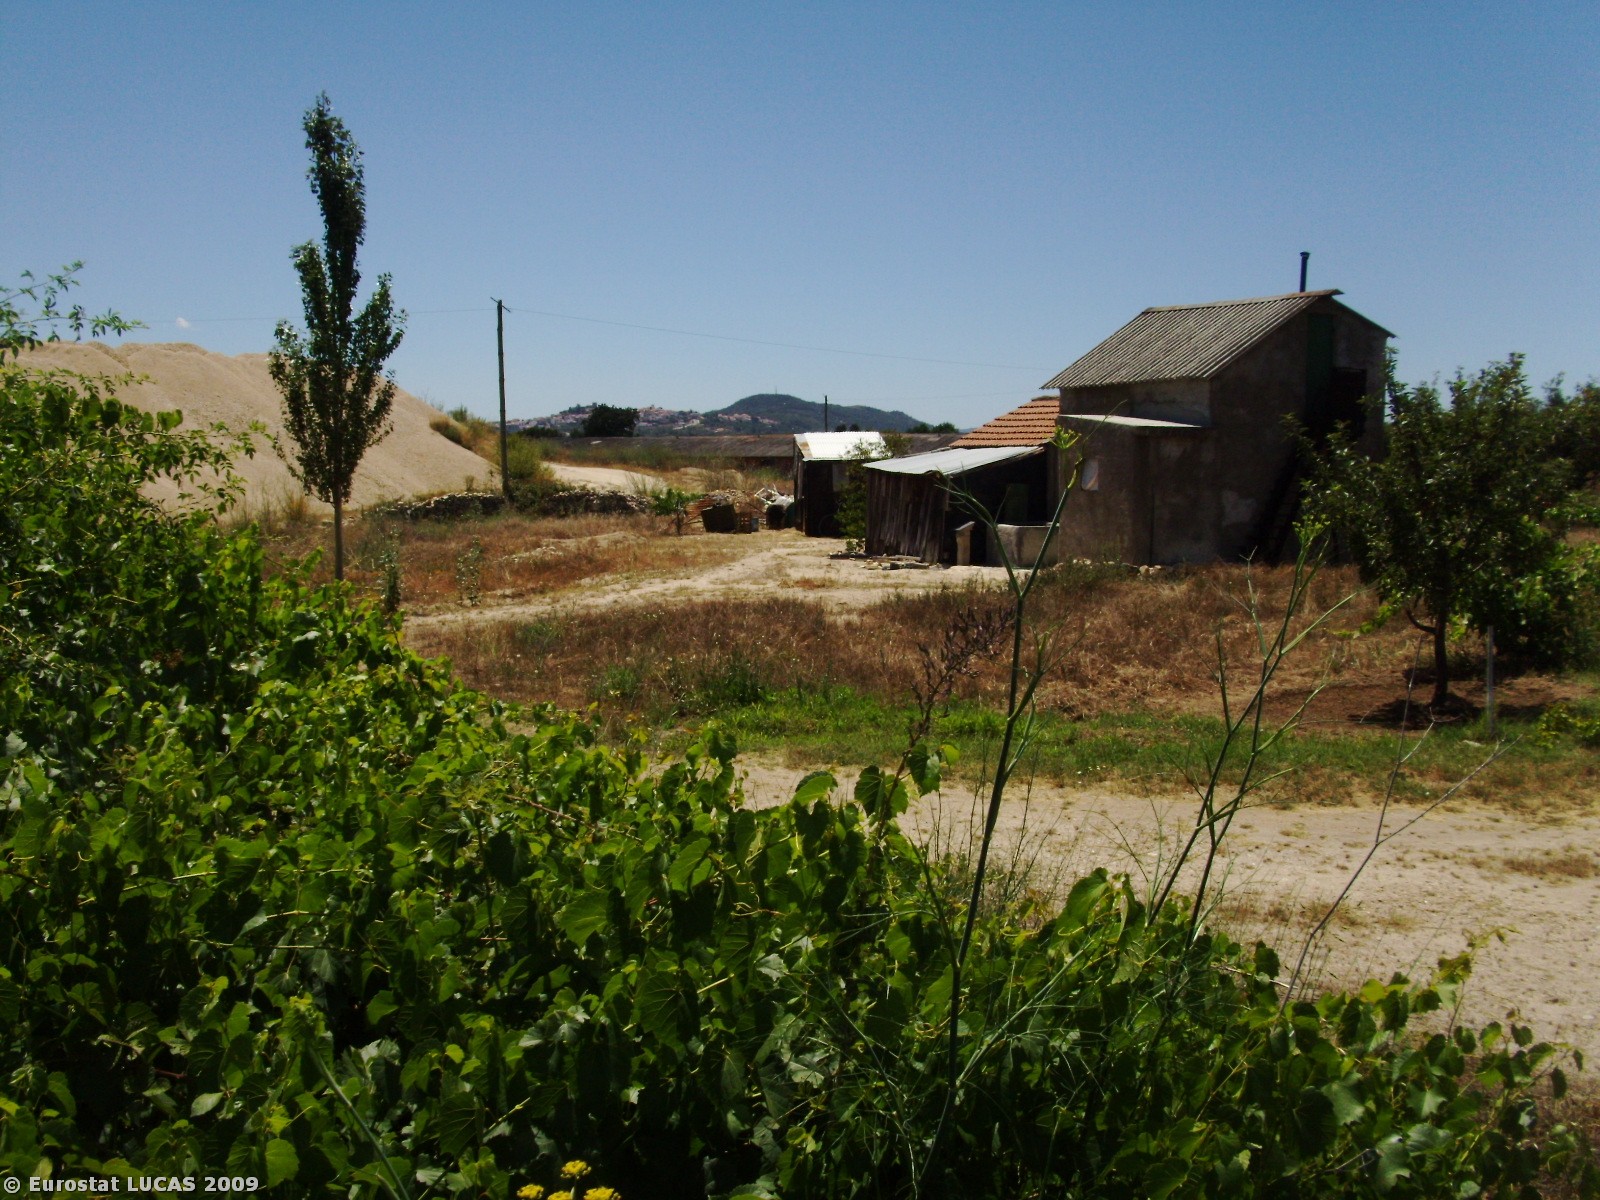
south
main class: Shrubland
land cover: Shrubland without tree cover
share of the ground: > 75 %
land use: Fallow land
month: July
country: PT
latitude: 40.4066
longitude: -7.3447
